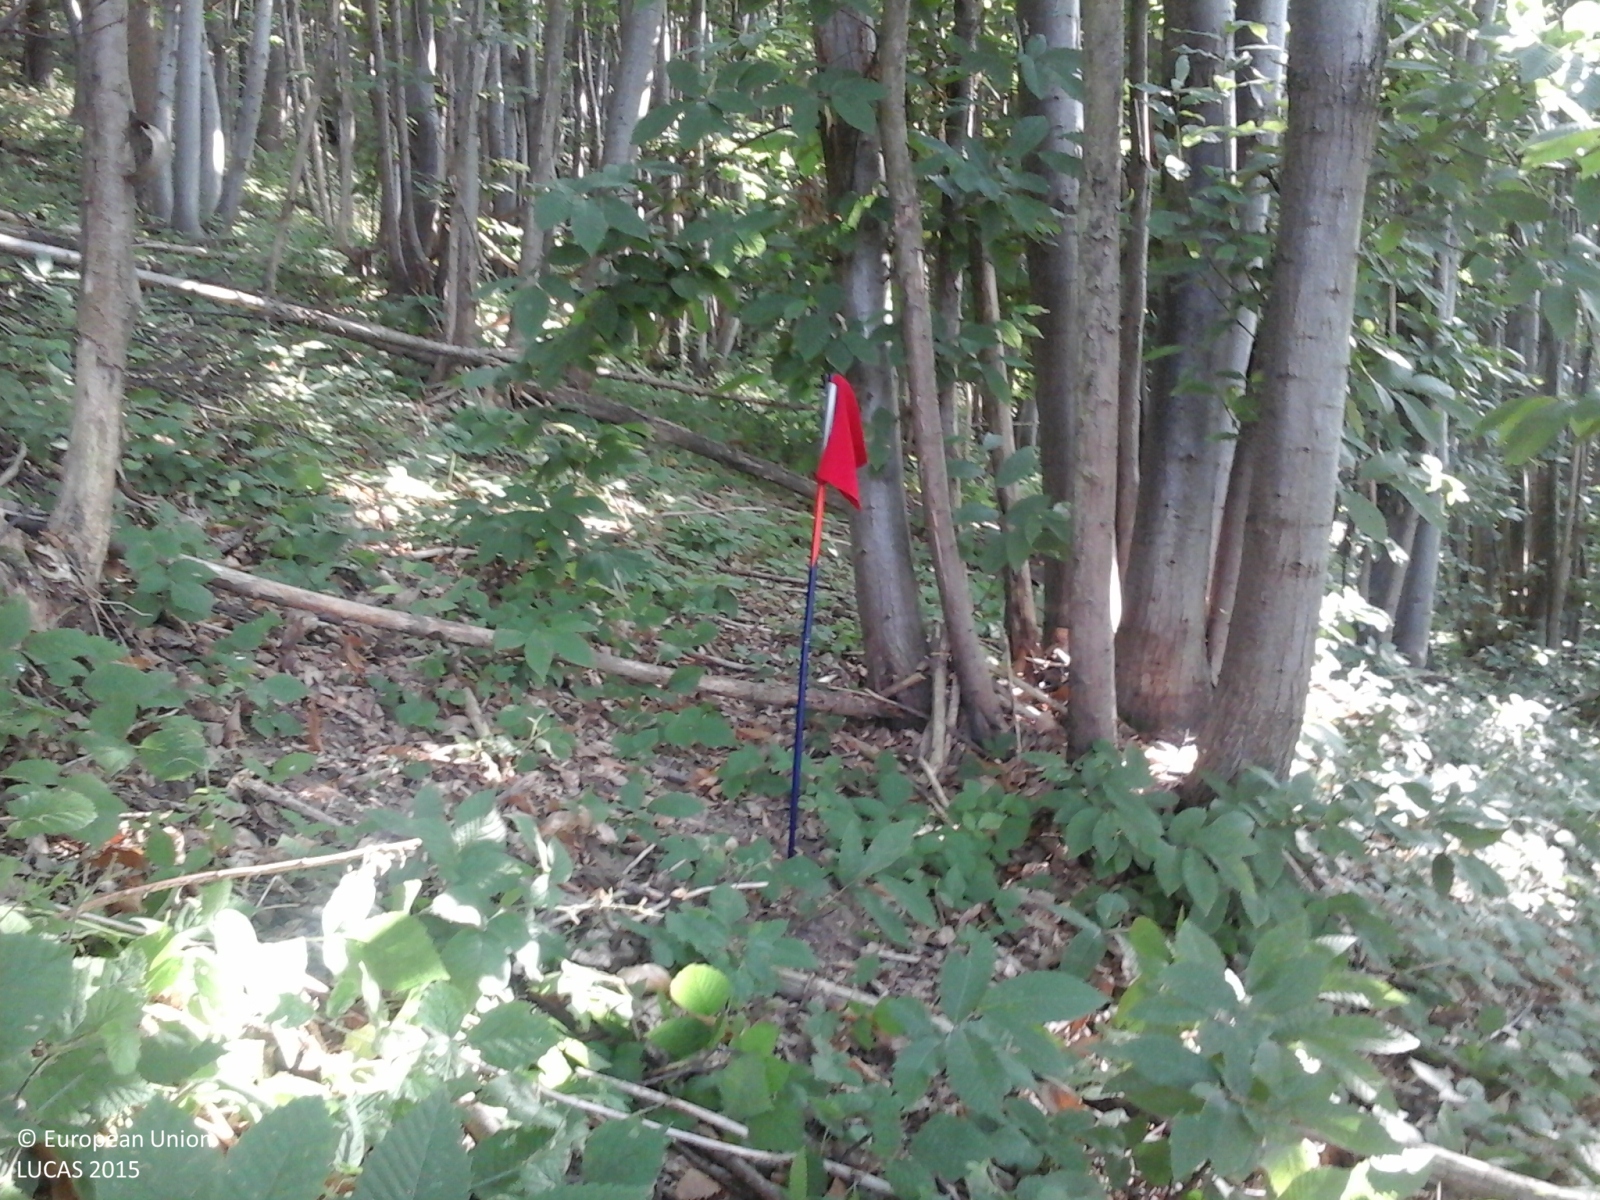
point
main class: Woodland
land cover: Broadleaved woodland
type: thermophilous deciduous forest
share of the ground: > 75 %
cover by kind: broadleaved forest trees 95 %, shrubs 5 %
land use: Forestry
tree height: > 5 m
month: July
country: IT
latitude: 44.3514
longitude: 8.1099
